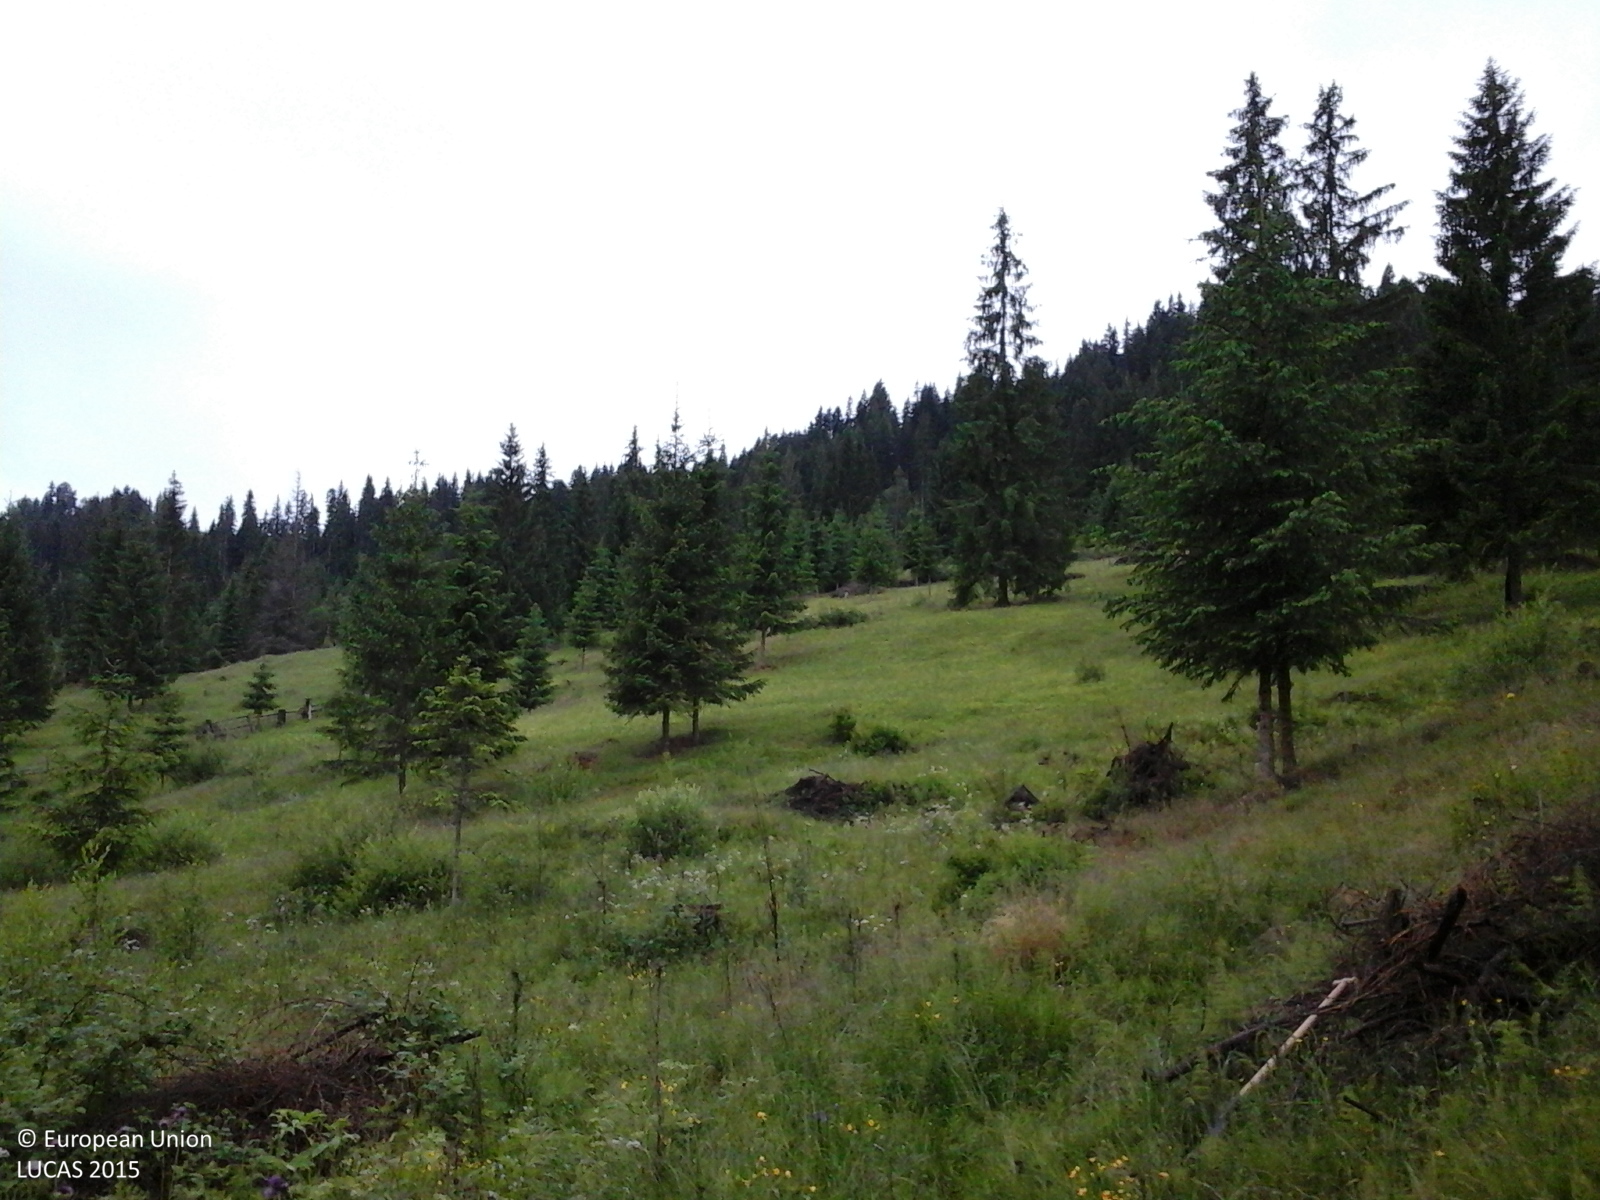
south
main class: Grassland
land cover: Grassland with sparse tree/shrub cover
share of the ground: > 75 %
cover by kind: herbaceous plants 85 %, shrubs 10 %, coniferous forest trees 5 %
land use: Agriculture (excluding fallow land and kitchen gardens)
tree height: > 5 m
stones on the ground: < 10 %
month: June
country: RO
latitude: 47.6029
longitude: 25.3156
